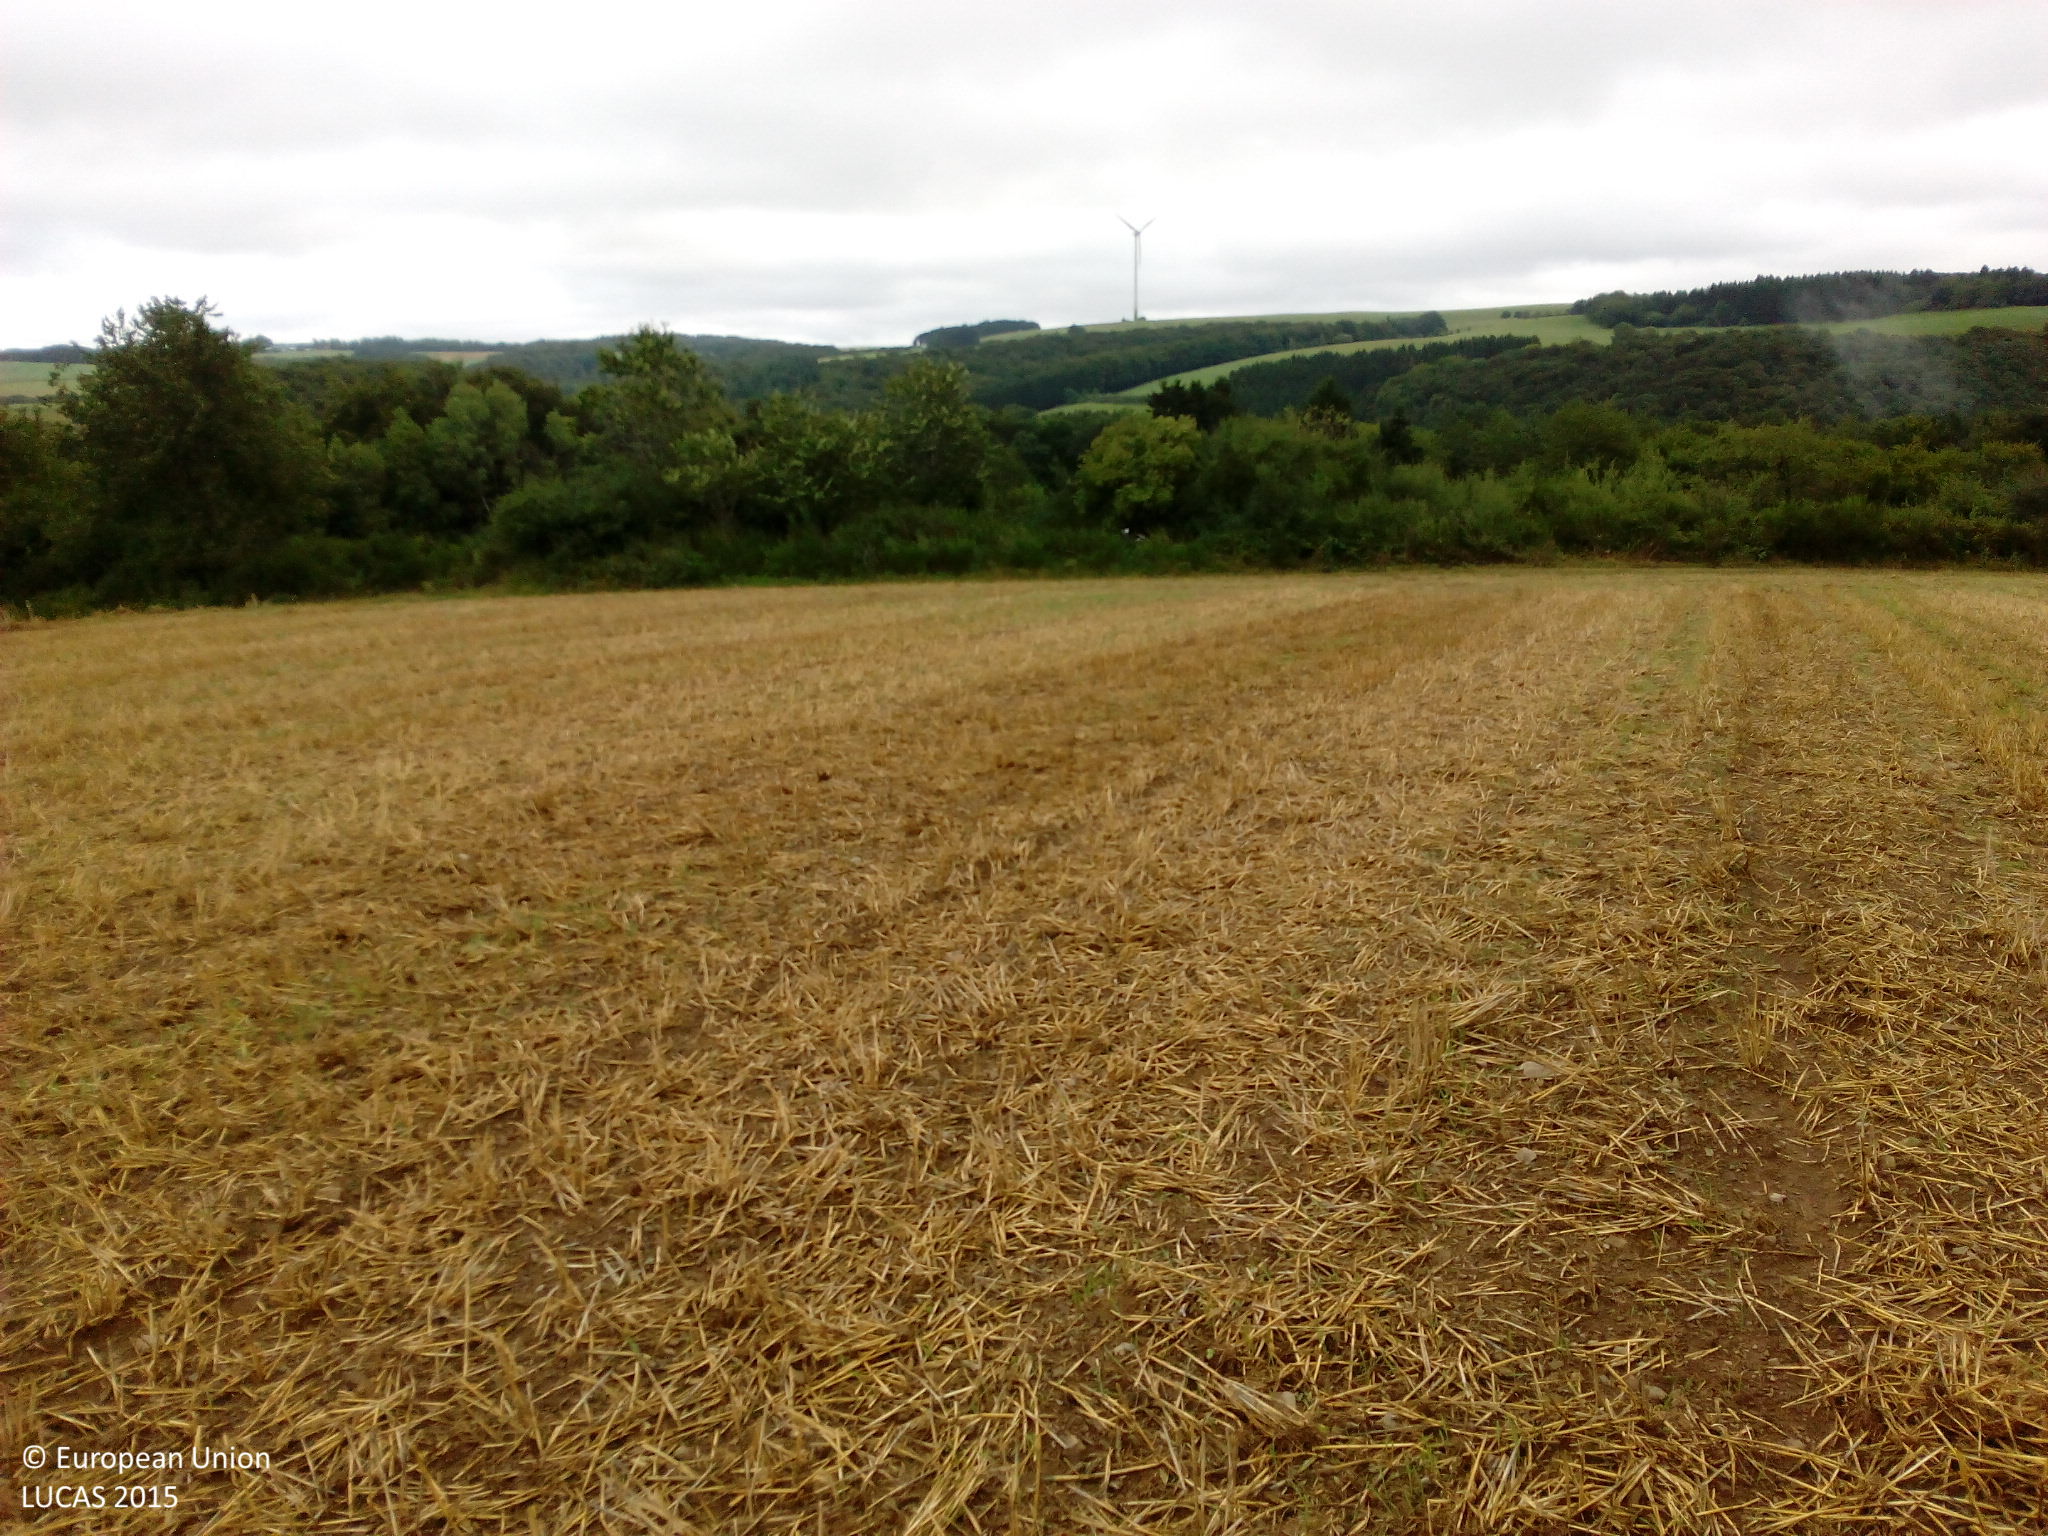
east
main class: Cropland
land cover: Rye
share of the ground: < 10 %
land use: Agriculture (excluding fallow land and kitchen gardens)
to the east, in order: Rye; Grass margins; Tracks; Broadleaved woodland; Fences; Grassland without tree/shrub cover; Fences; Grass margins; Tracks; Broadleaved woodland
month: August
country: DE
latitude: 50.0522
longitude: 6.2984
